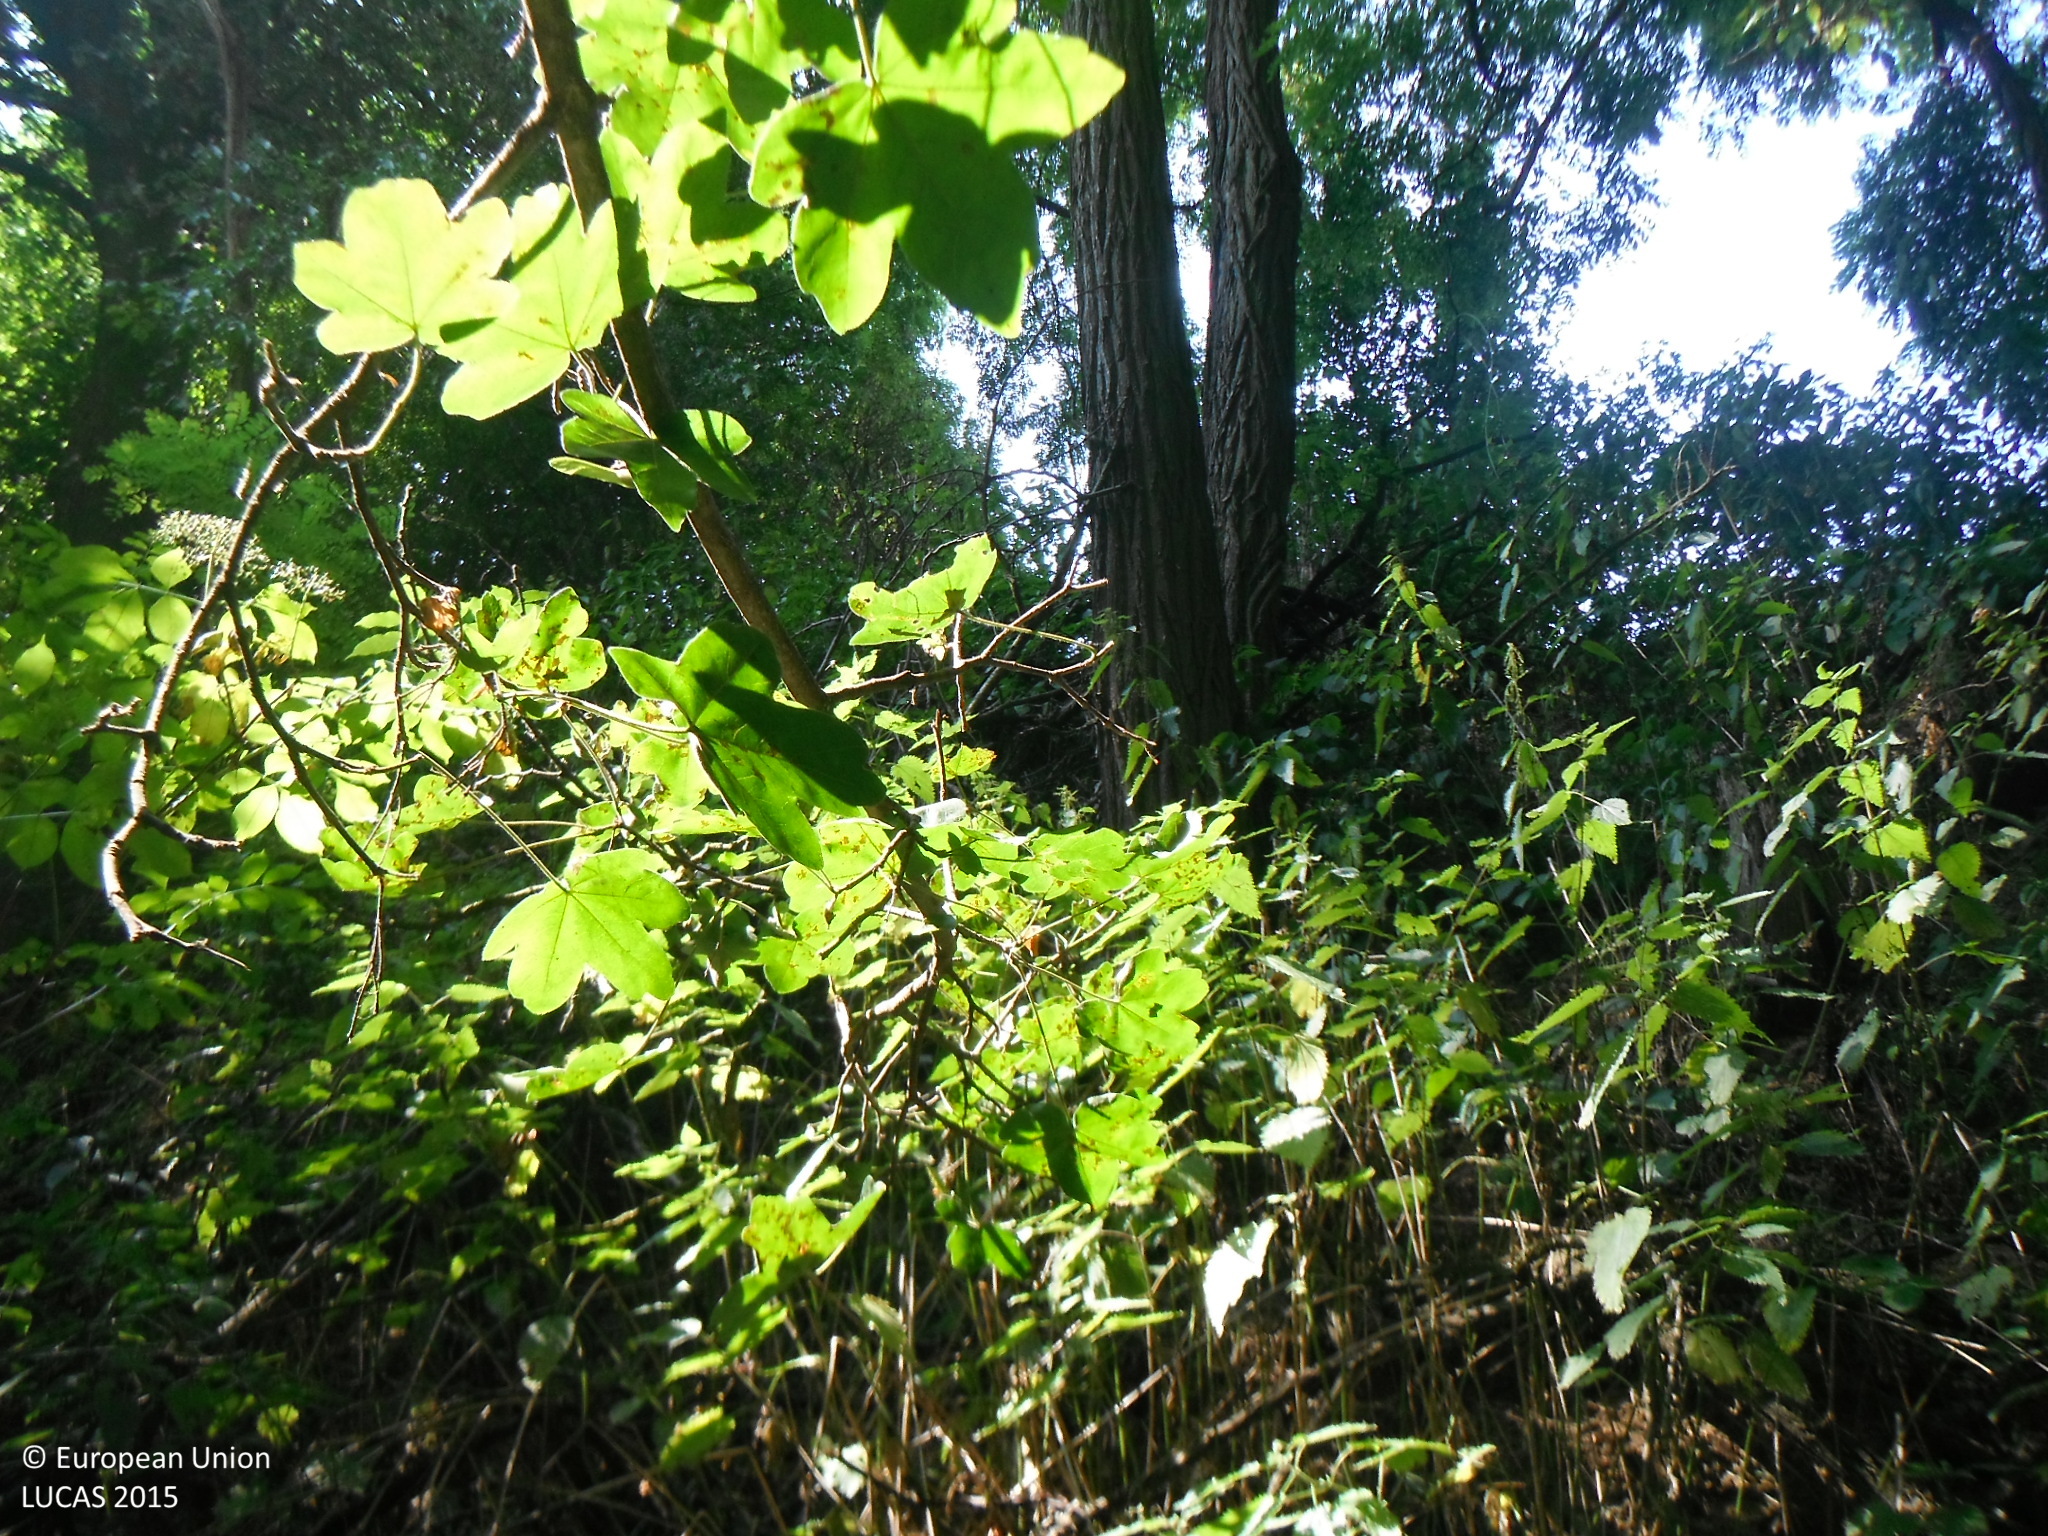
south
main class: Woodland
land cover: Broadleaved woodland
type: mesophytic deciduous forest
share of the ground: > 75 %
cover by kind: broadleaved forest trees 90 %, shrubs 5 %, herbaceous plants 5 %
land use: Semi-natural and natural areas not in use
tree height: > 5 m
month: July
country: SK
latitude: 48.6391
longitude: 17.4611
